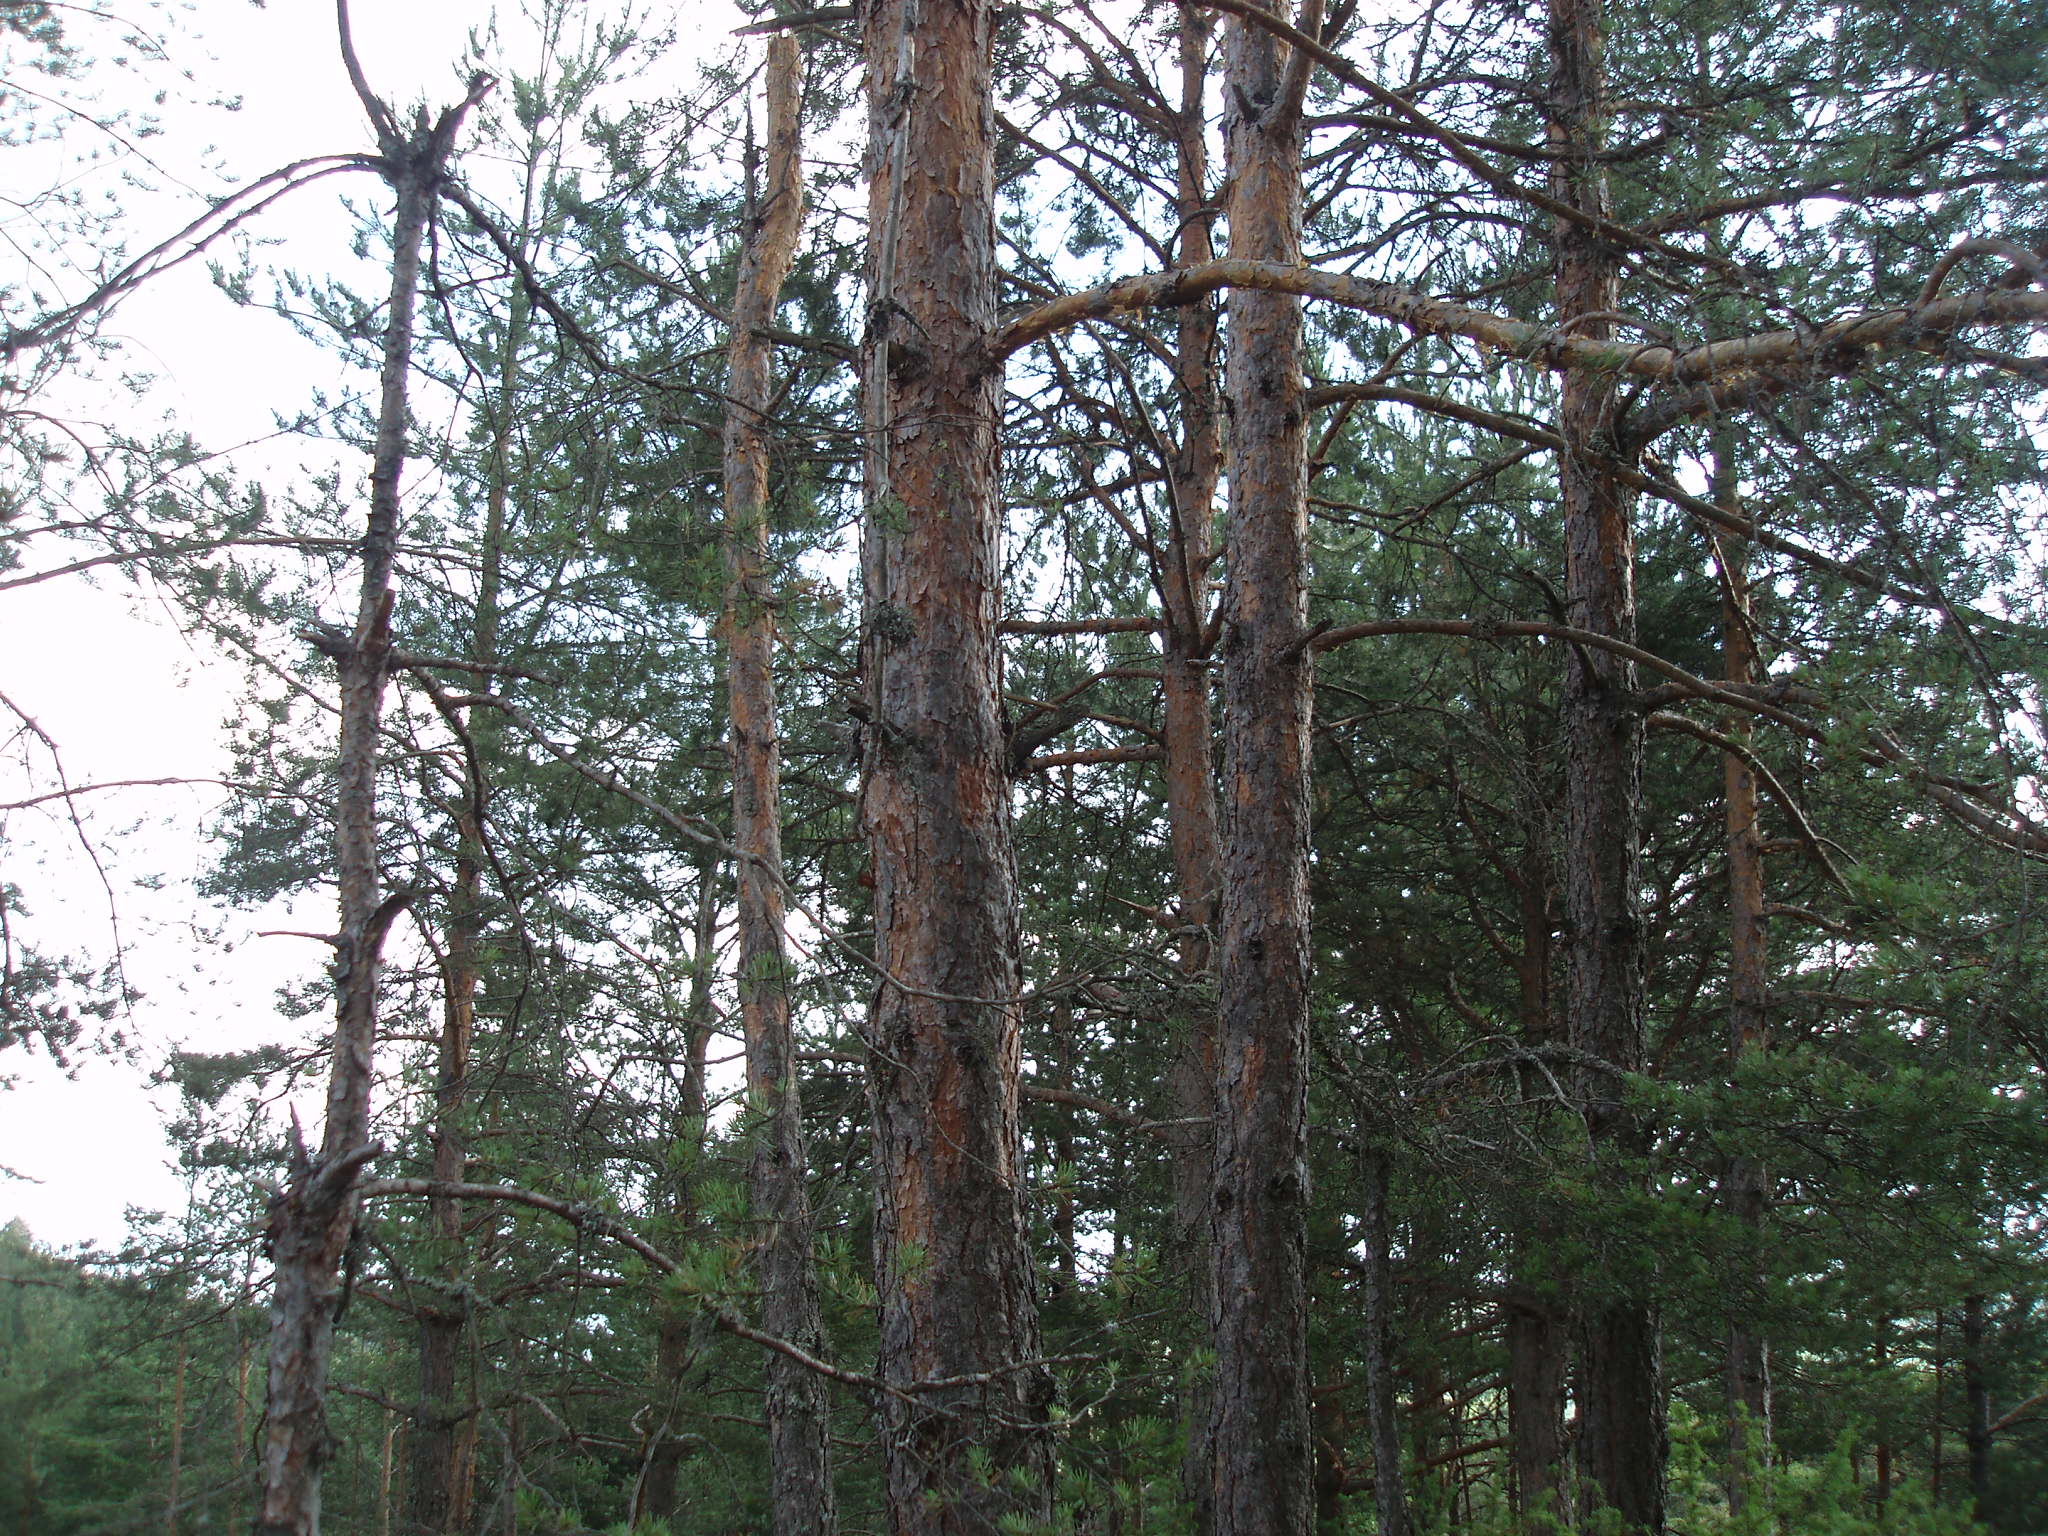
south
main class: Woodland
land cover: Pine dominated coniferous woodland
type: hemiboreal forest and nemoral coniferous forest and mixed broadleaved-coniferous forest
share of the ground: > 75 %
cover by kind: coniferous forest trees 90 %, unconsolidated bare surface 10 %
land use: Forestry
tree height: > 5 m
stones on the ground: 10 - 25 %
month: July
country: BG
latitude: 41.9641
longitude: 23.5071
